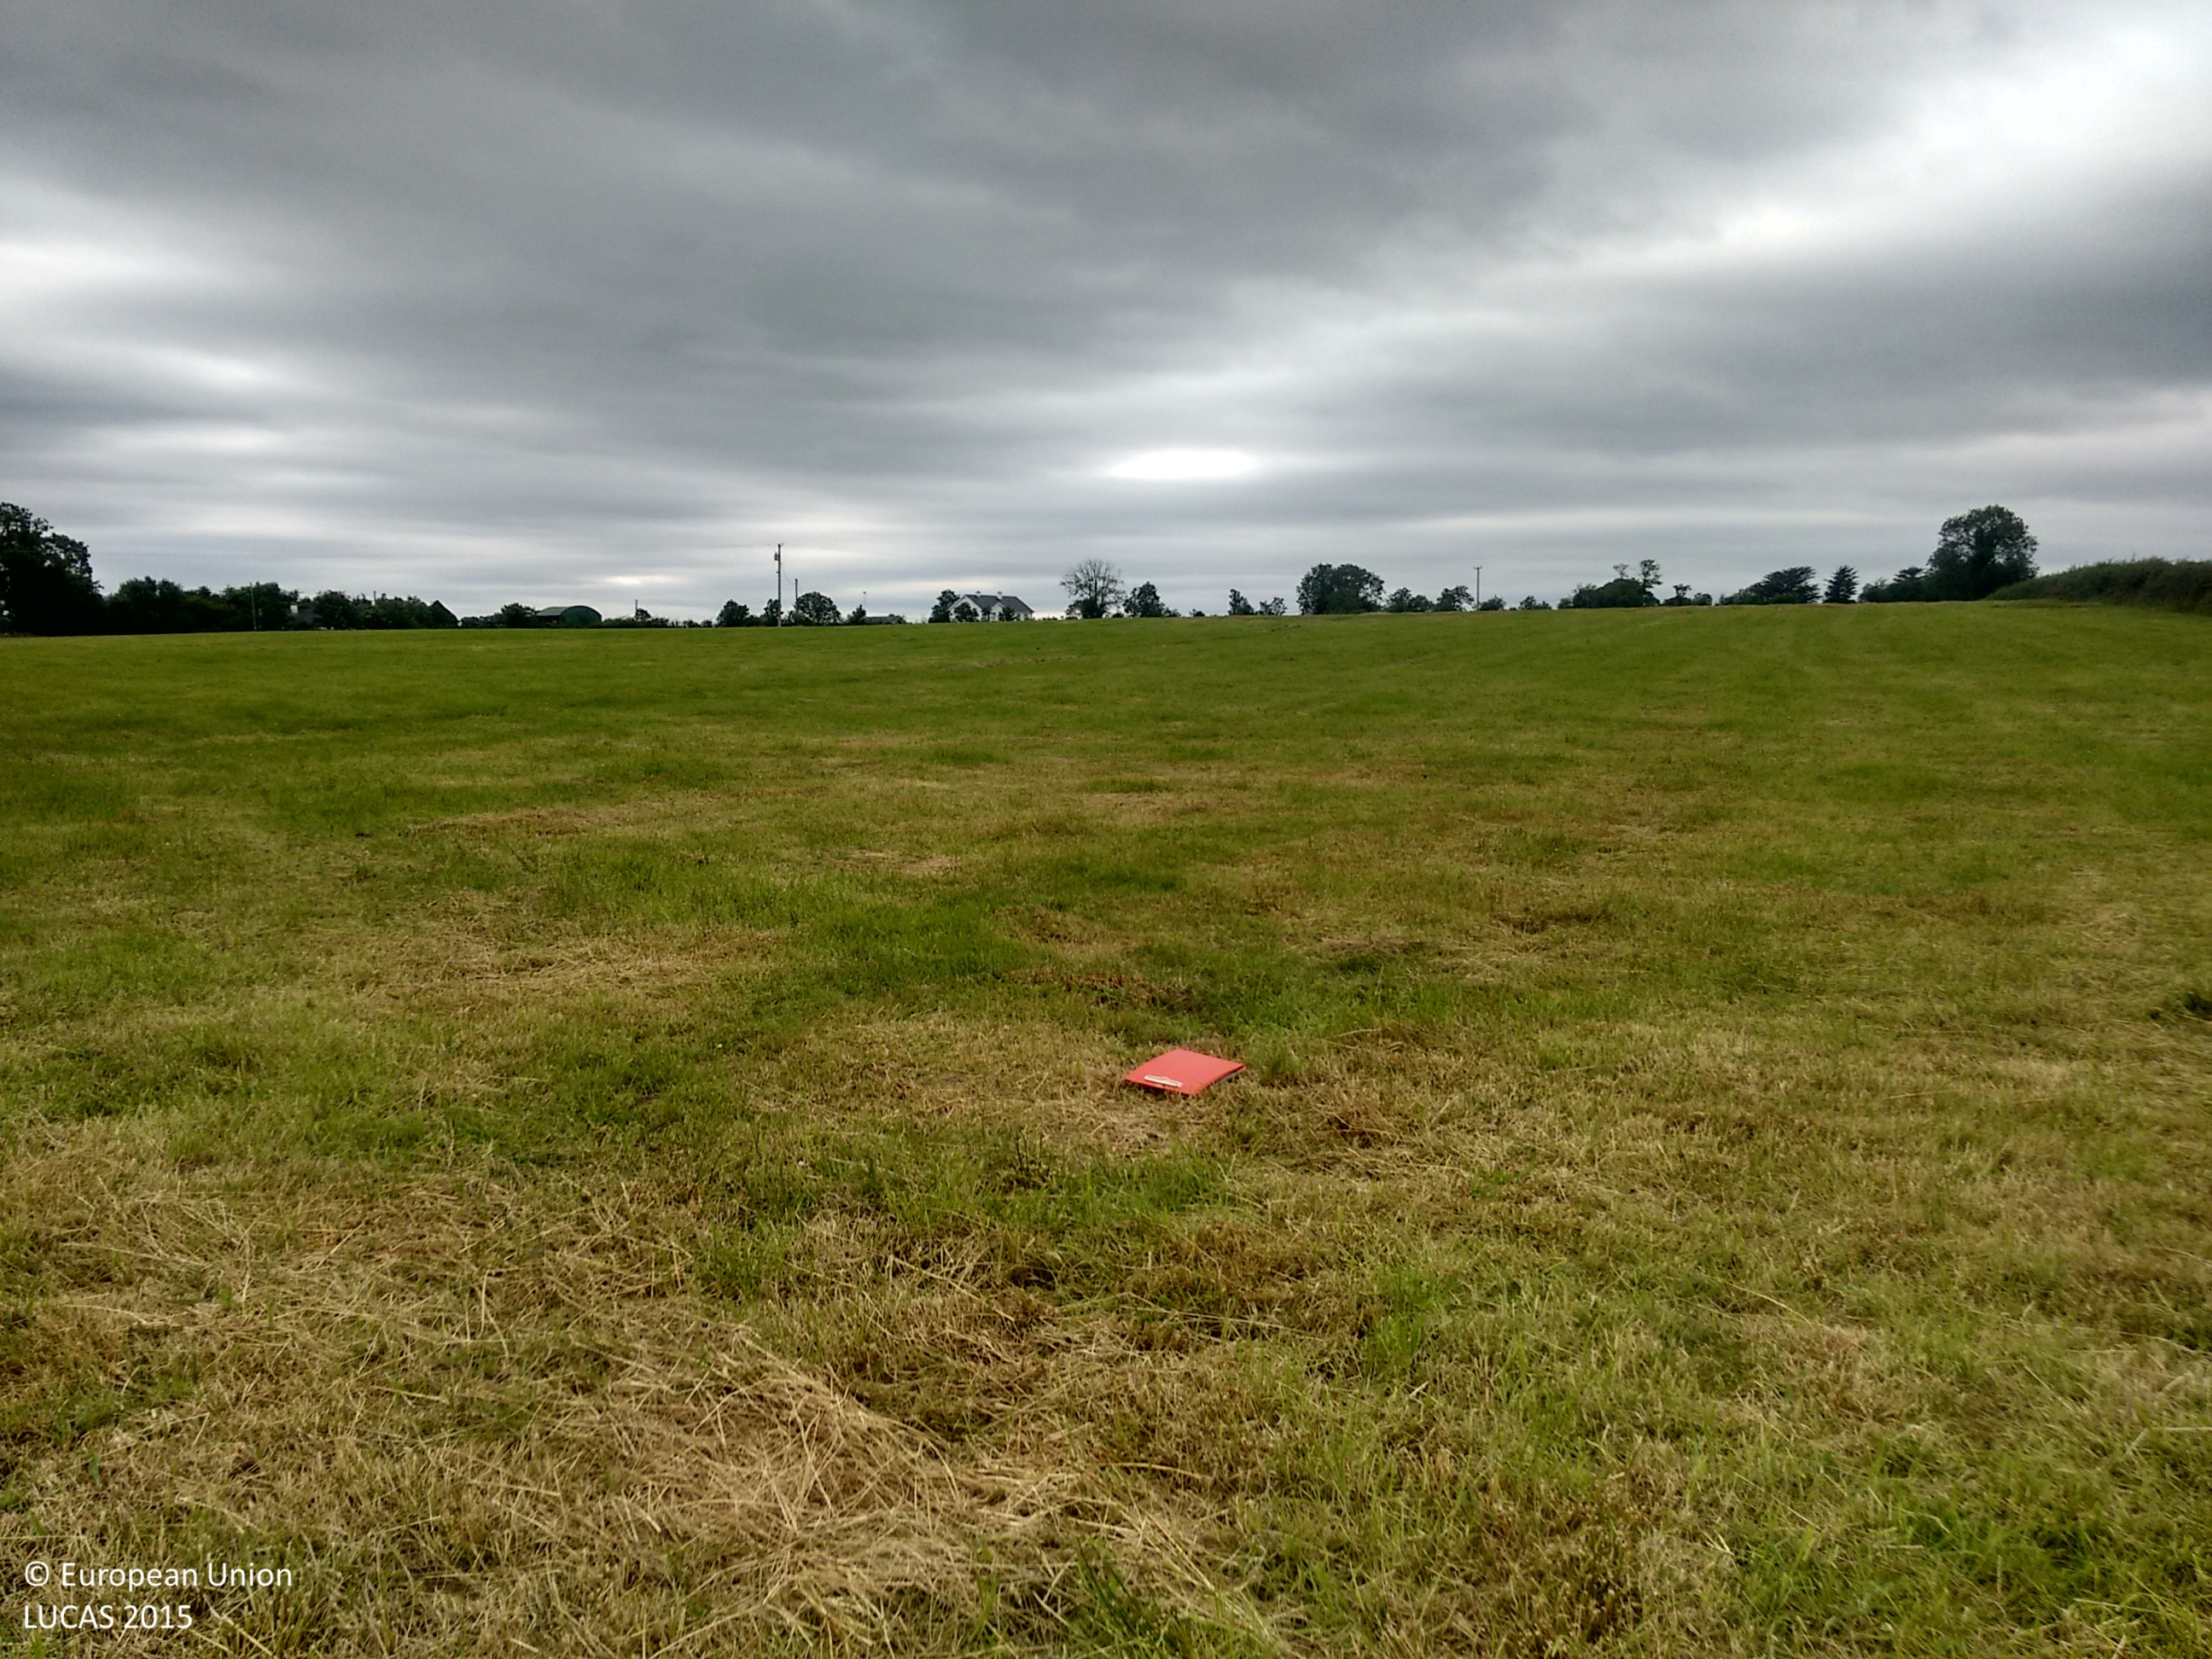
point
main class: Grassland
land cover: Grassland without tree/shrub cover
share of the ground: > 75 %
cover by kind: herbaceous plants 100 %
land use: Agriculture (excluding fallow land and kitchen gardens)
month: July
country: IE
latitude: 53.6621
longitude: -8.1117
